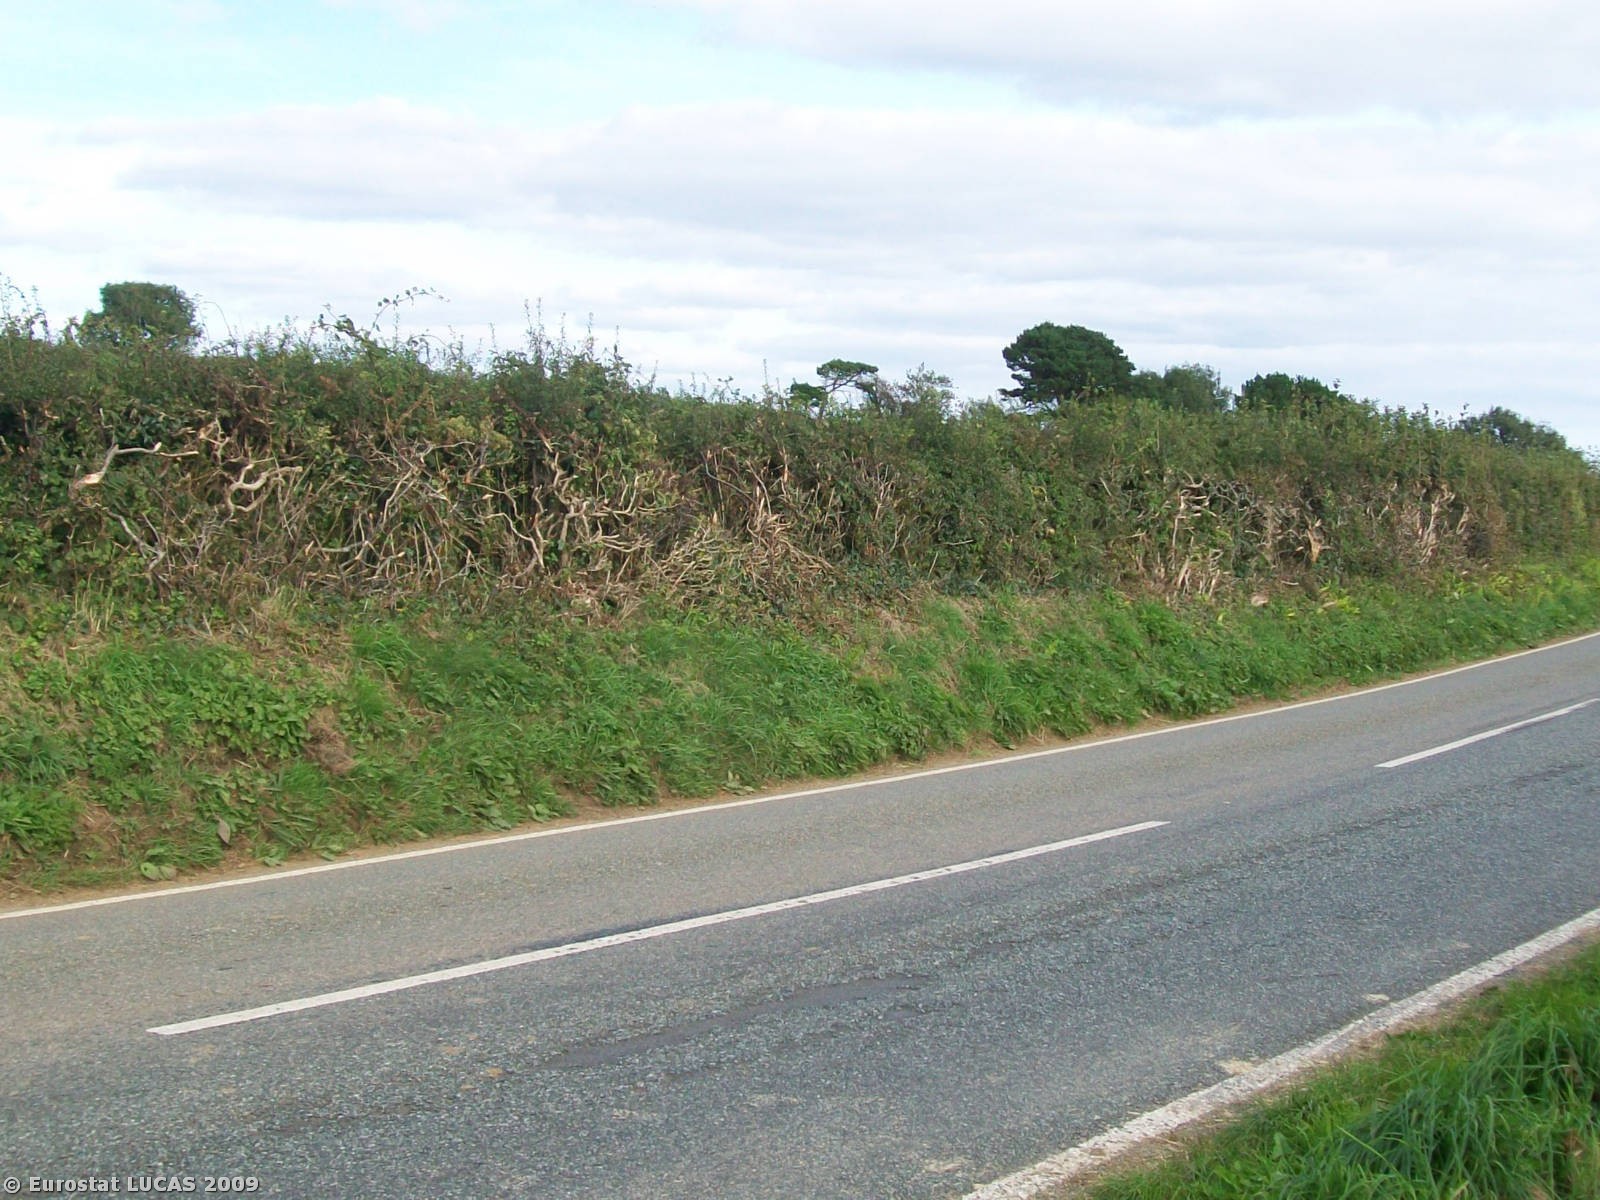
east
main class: Cropland
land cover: Common wheat
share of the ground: 10 - 25 %
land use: Agriculture (excluding fallow land and kitchen gardens)
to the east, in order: Common wheat; Managed hedges; Lines of trees; Broadleaved woodland
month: September
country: GB
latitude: 51.7509
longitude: -4.9637
